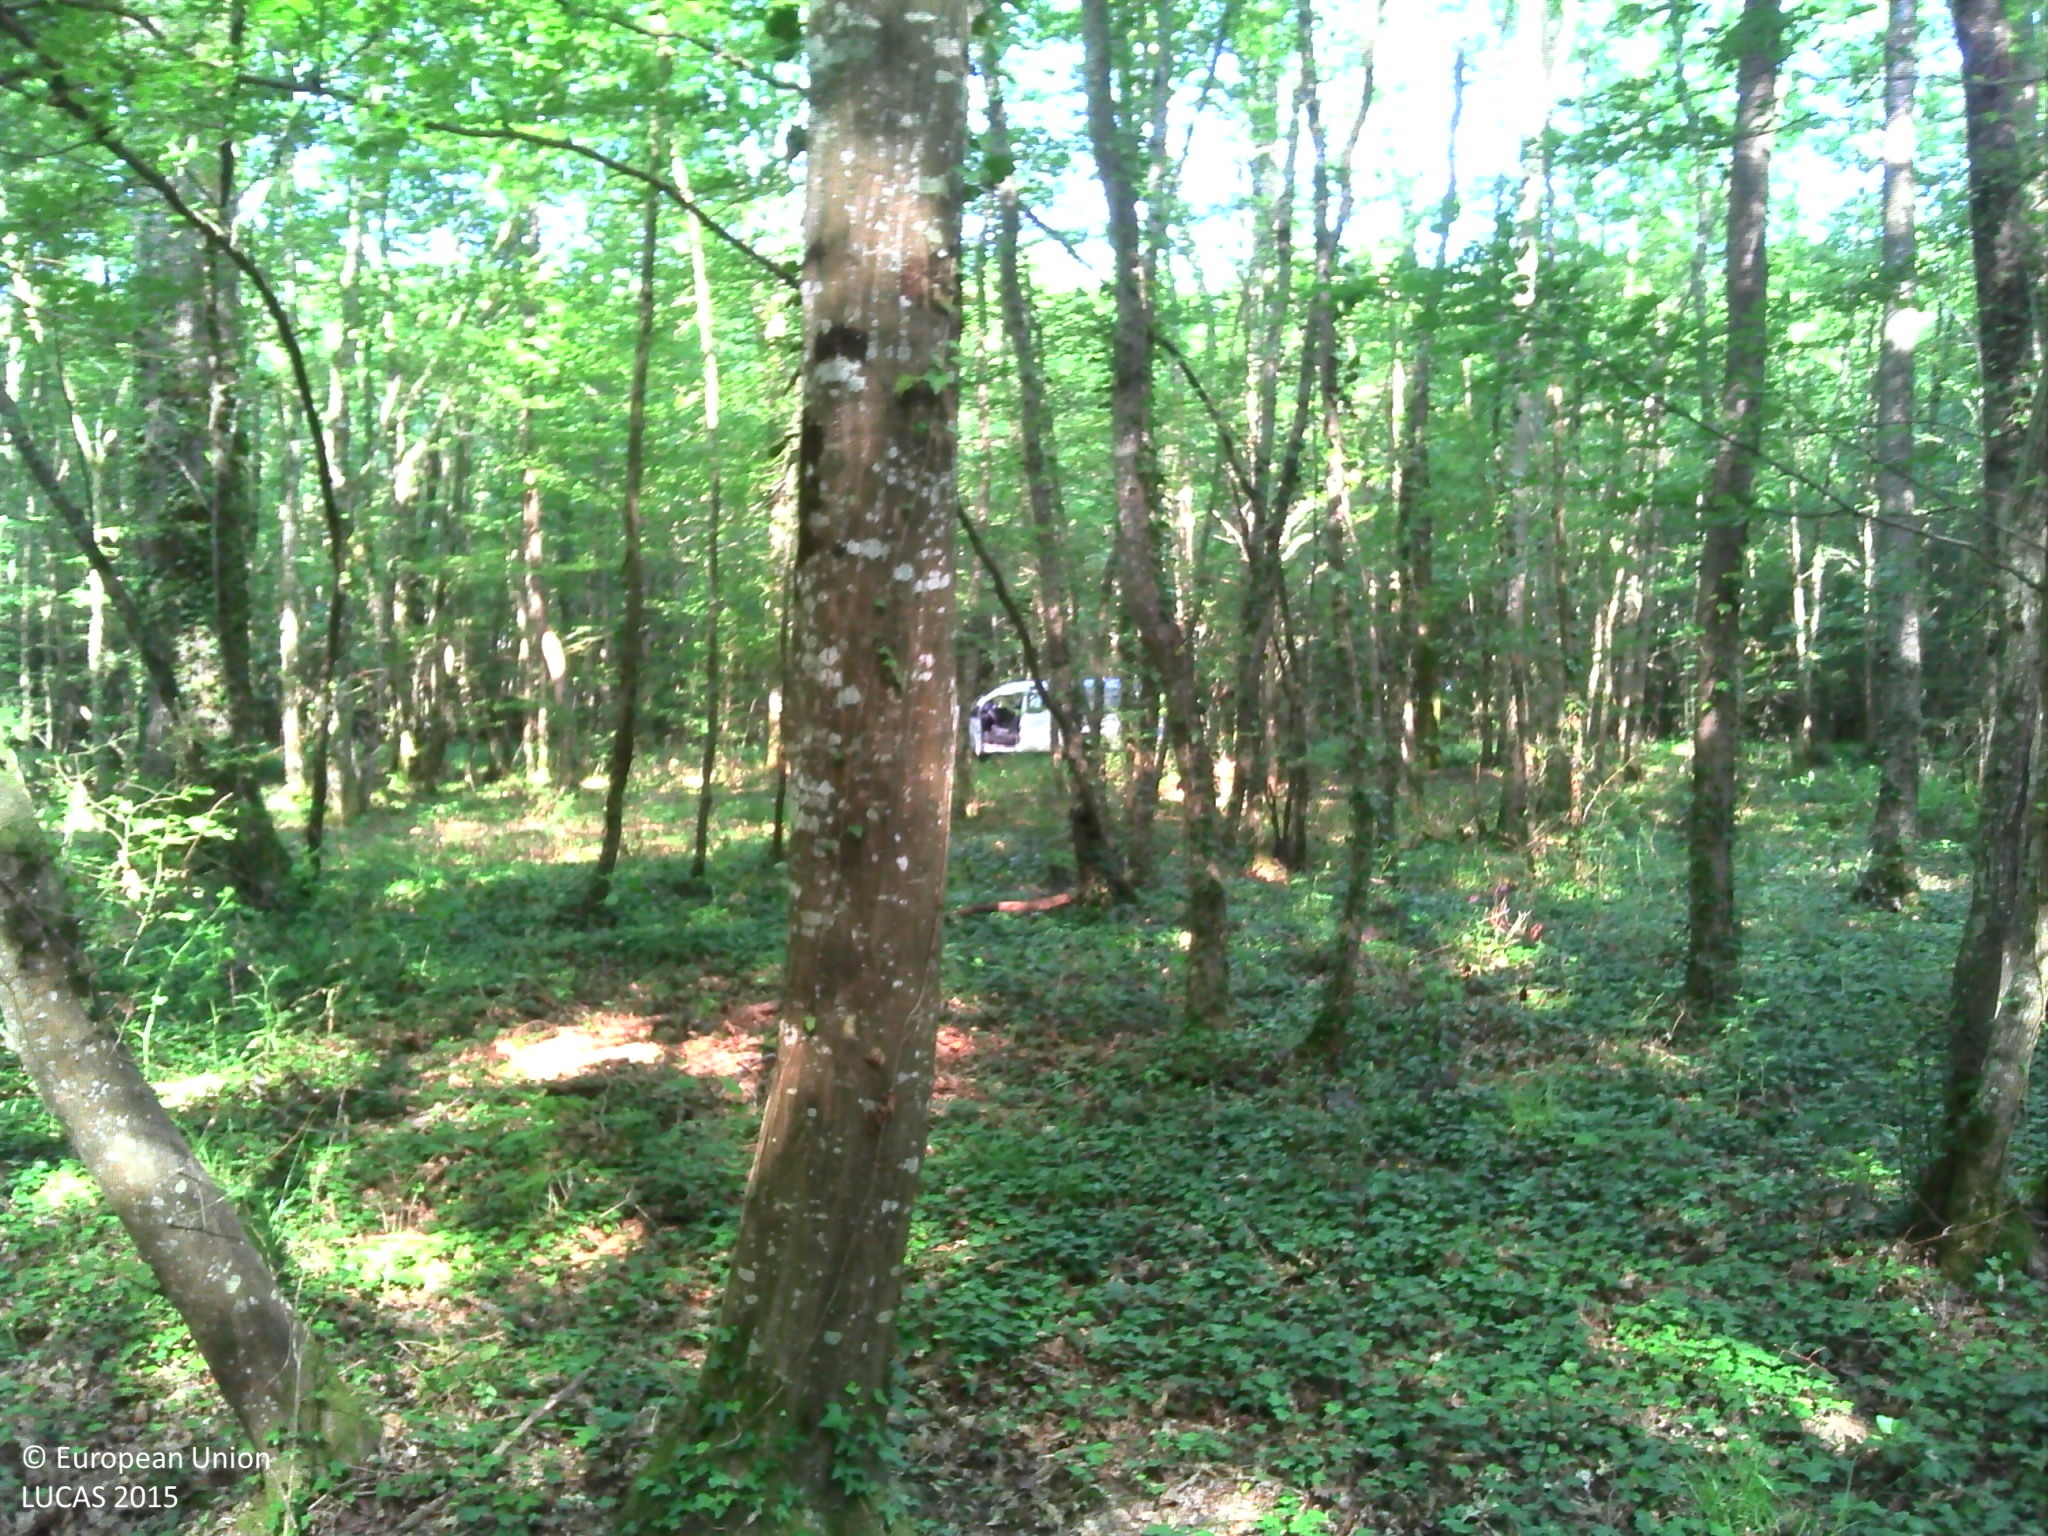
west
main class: Woodland
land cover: Broadleaved woodland
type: mesophytic deciduous forest
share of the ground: > 75 %
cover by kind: broadleaved forest trees 100 %
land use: Forestry
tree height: > 5 m
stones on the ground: < 10 %
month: June
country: FR
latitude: 47.0911
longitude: 2.6298
